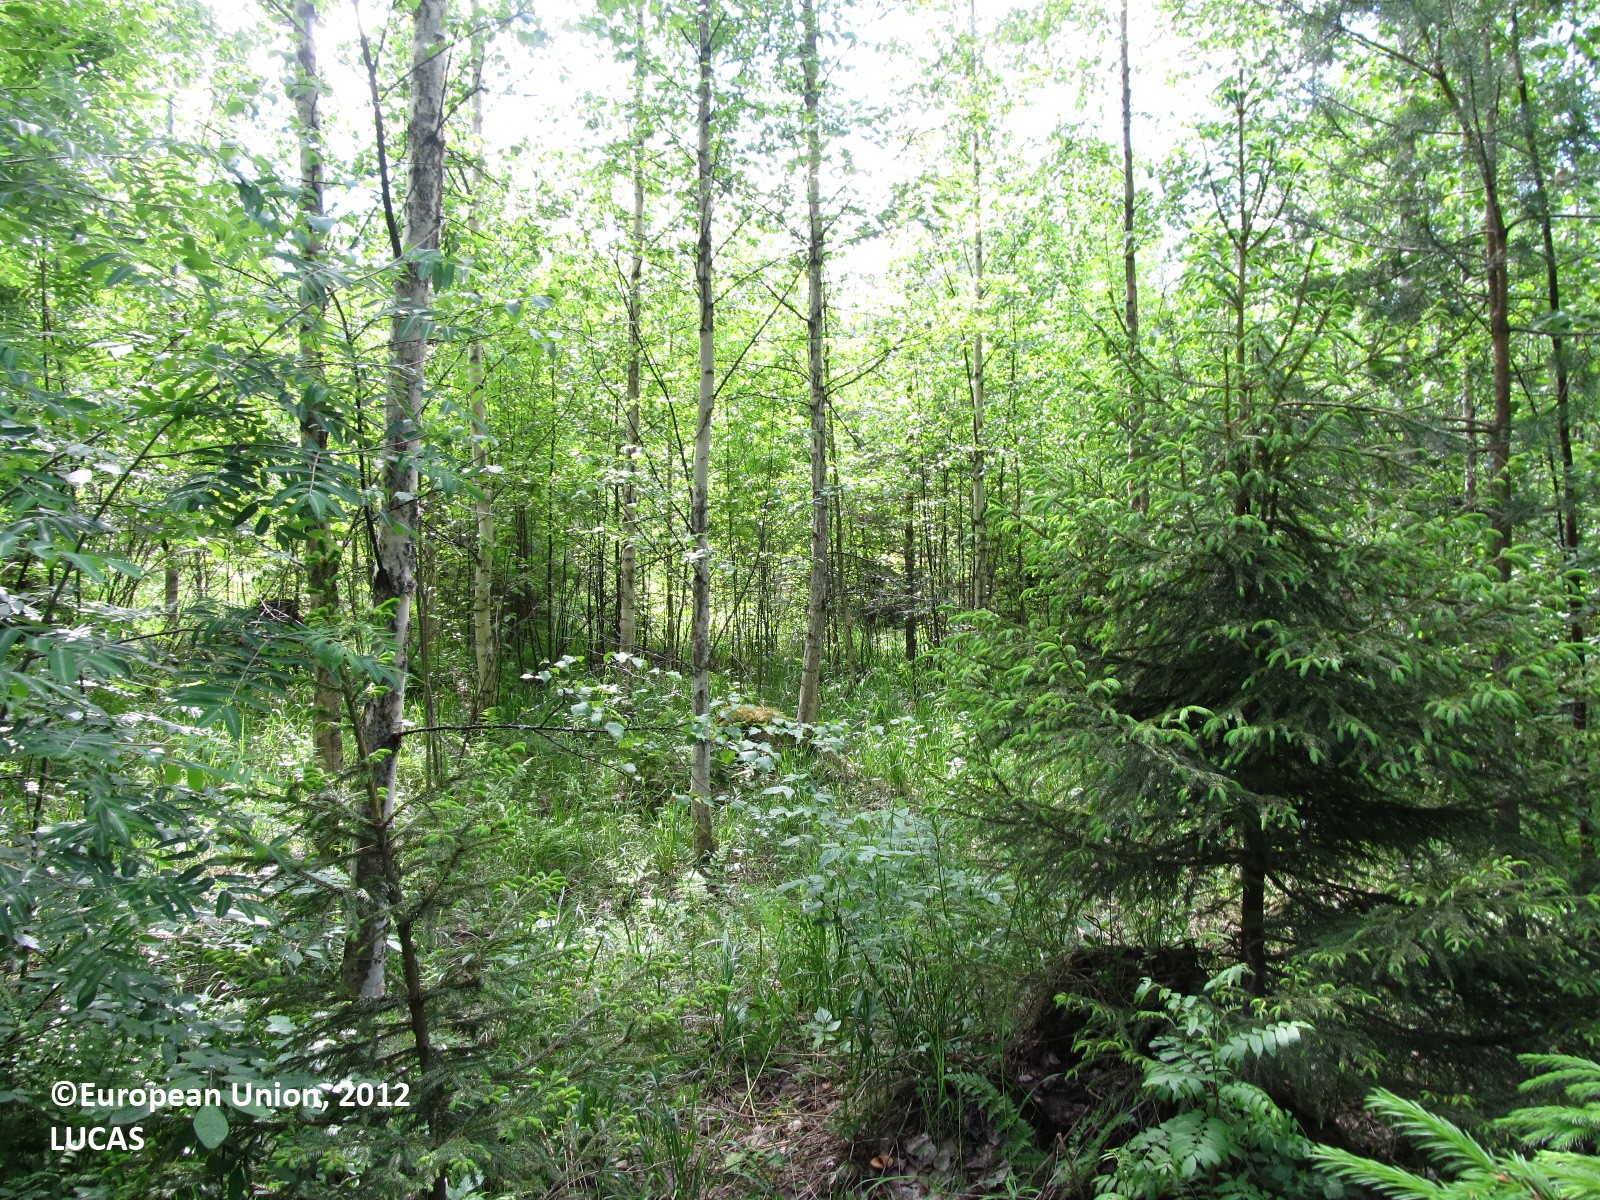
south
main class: Woodland
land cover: Broadleaved woodland
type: boreal forest
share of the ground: 50 - 75 %
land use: Forestry
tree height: > 5 m
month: June
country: FI
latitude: 62.8760
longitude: 27.4834
